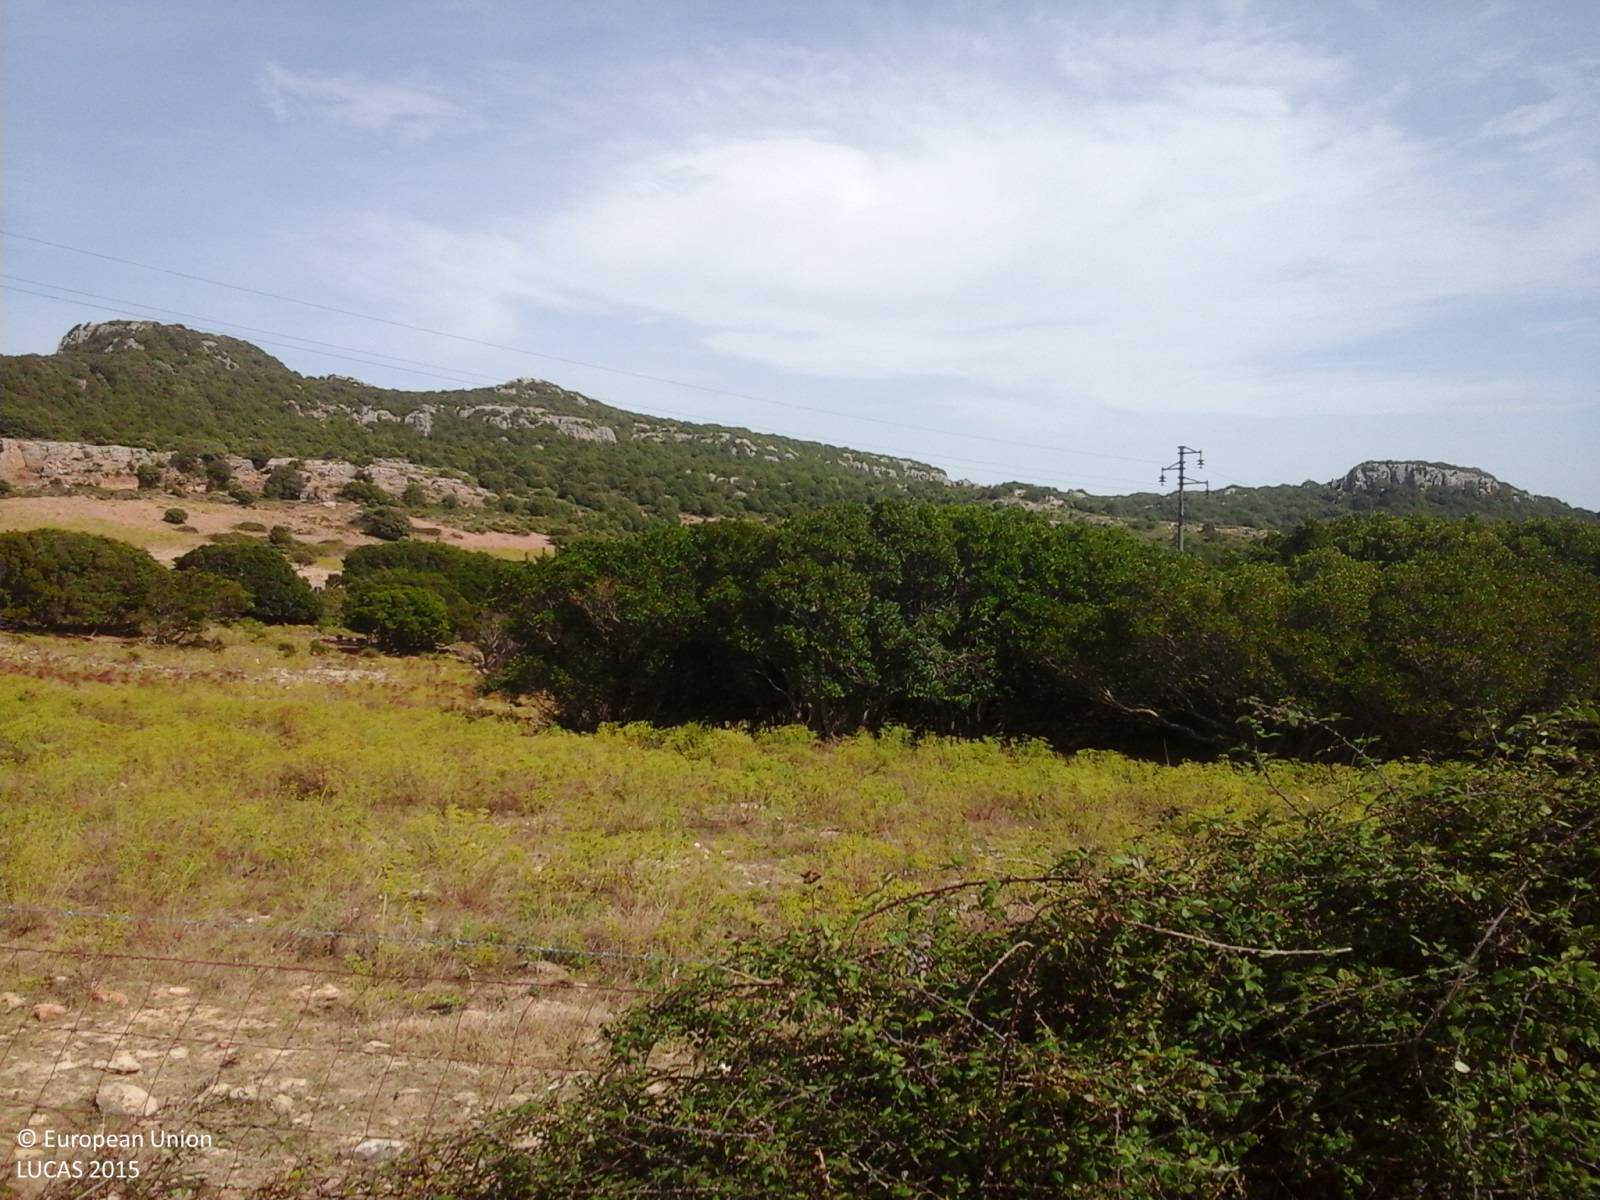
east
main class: Grassland
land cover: Grassland without tree/shrub cover
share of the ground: > 75 %
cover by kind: unconsolidated bare surface 40 %, herbaceous plants 35 %, consolidated bare surface 25 %
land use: Agriculture (excluding fallow land and kitchen gardens)
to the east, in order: Grassland without tree/shrub cover; Paved roads, cycling and walking lanes; Grass margins; Fences; Oats; Shrubland without tree cover; Electric lines; Oats; Fences; Abandoned hedges; Grass margins; Paved roads, cycling and walking lanes; Grass margins; Fences; Grassland without tree/shrub cover
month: September
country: IT
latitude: 39.8126
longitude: 9.3611
